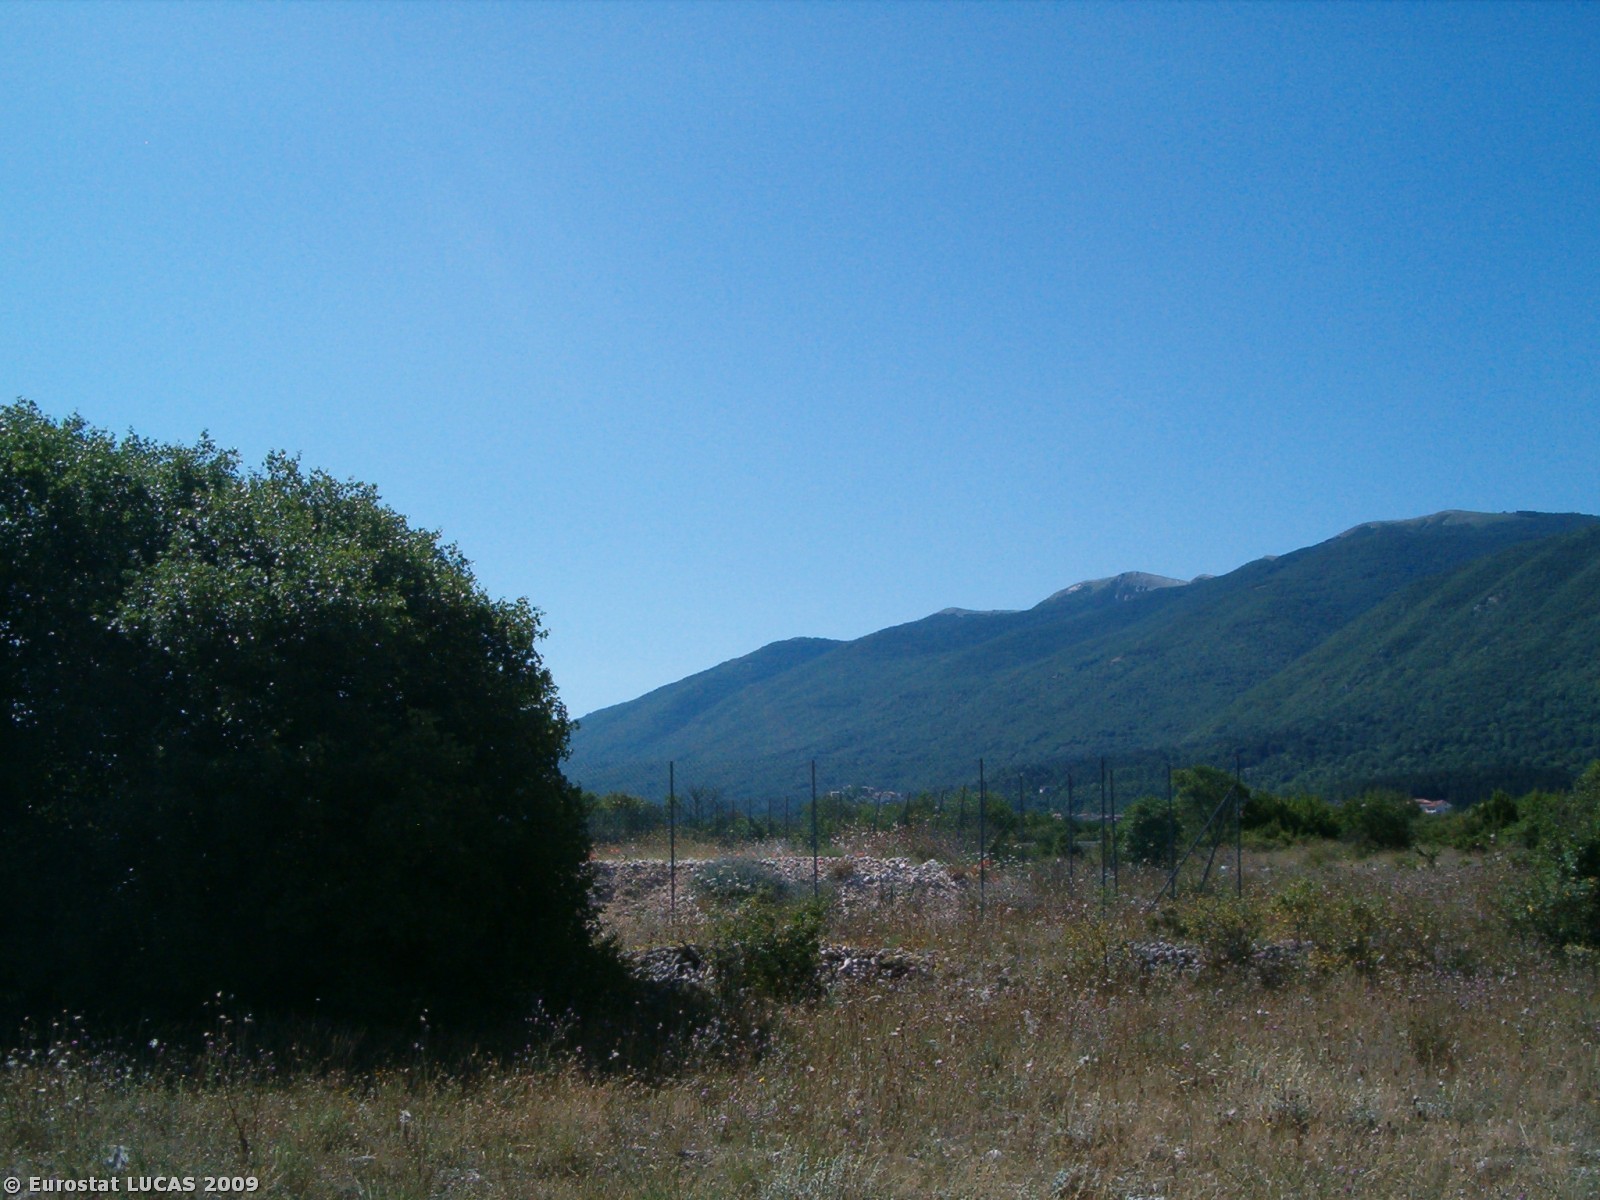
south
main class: Grassland
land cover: Grassland without tree/shrub cover
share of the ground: > 75 %
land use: Agriculture (excluding fallow land and kitchen gardens)
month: July
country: IT
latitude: 41.8843
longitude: 13.6146
